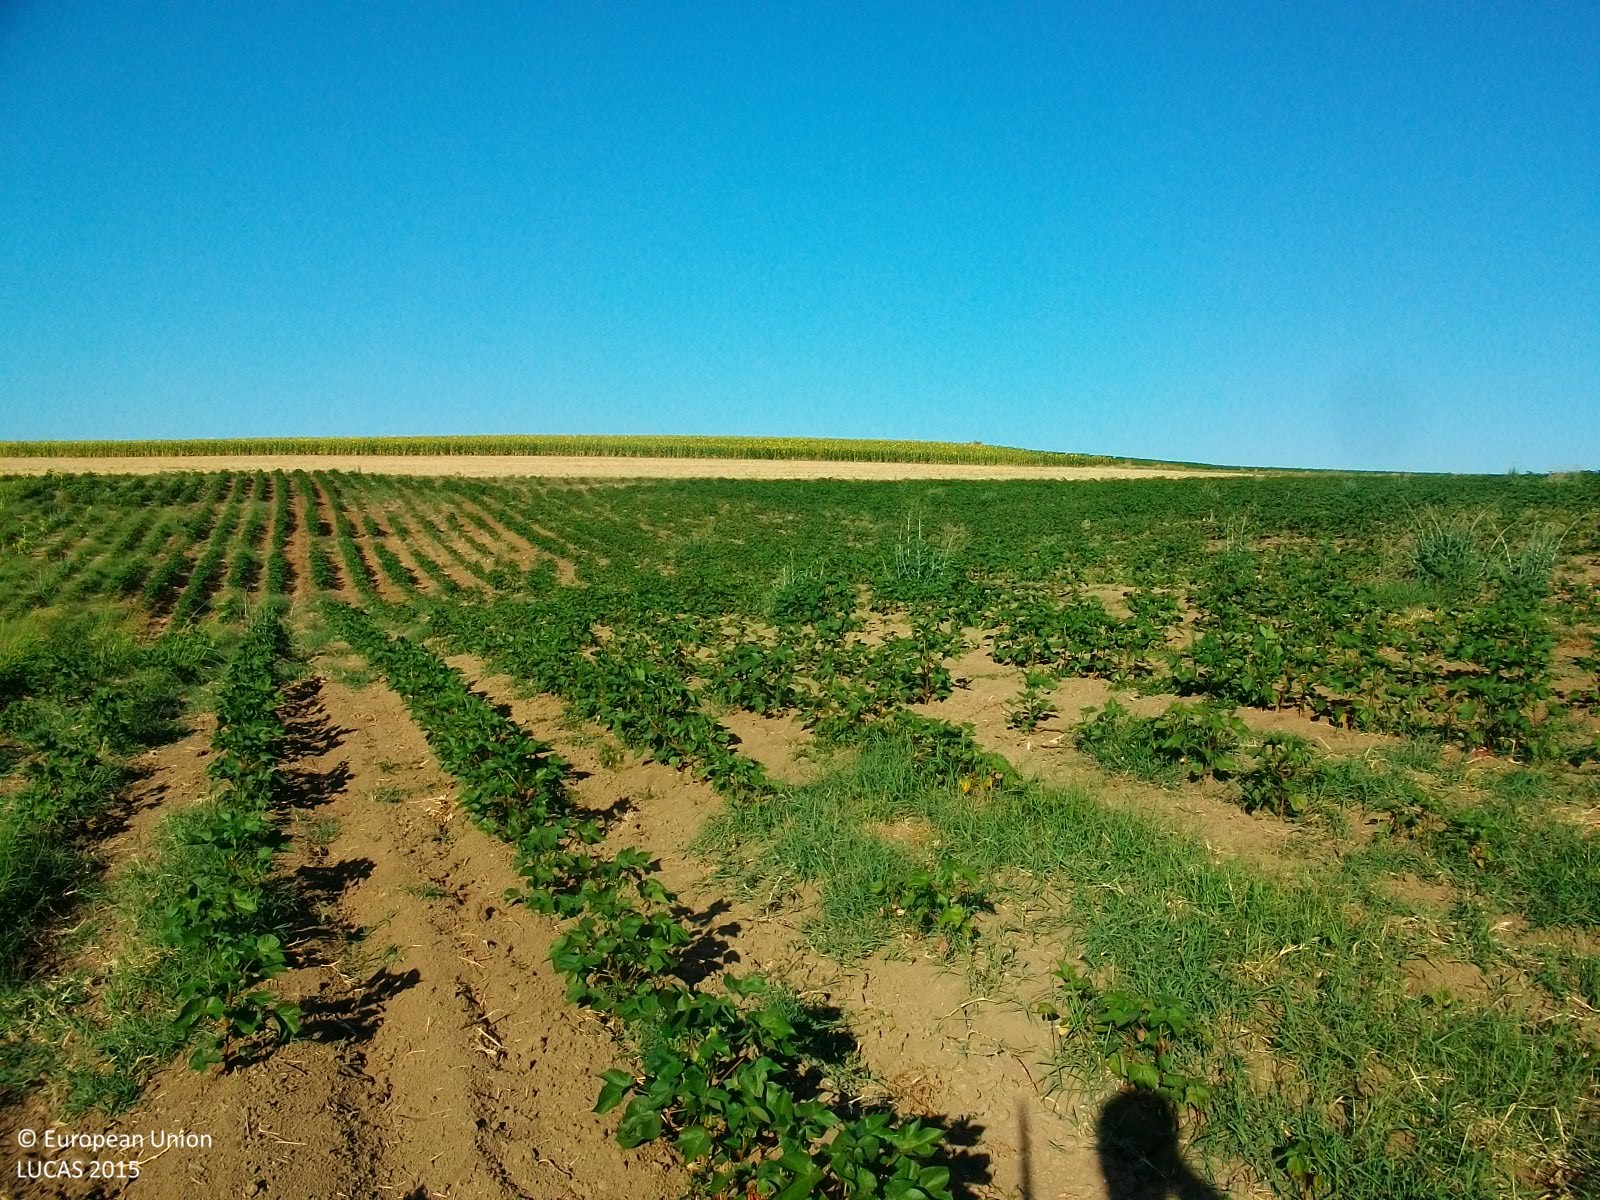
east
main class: Cropland
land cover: Cotton
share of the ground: 25 - 50 %
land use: Agriculture (excluding fallow land and kitchen gardens)
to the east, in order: Cotton; Grass margins; Common wheat; Sunflower; Common wheat
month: July
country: GR
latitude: 41.4607
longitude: 26.2470
